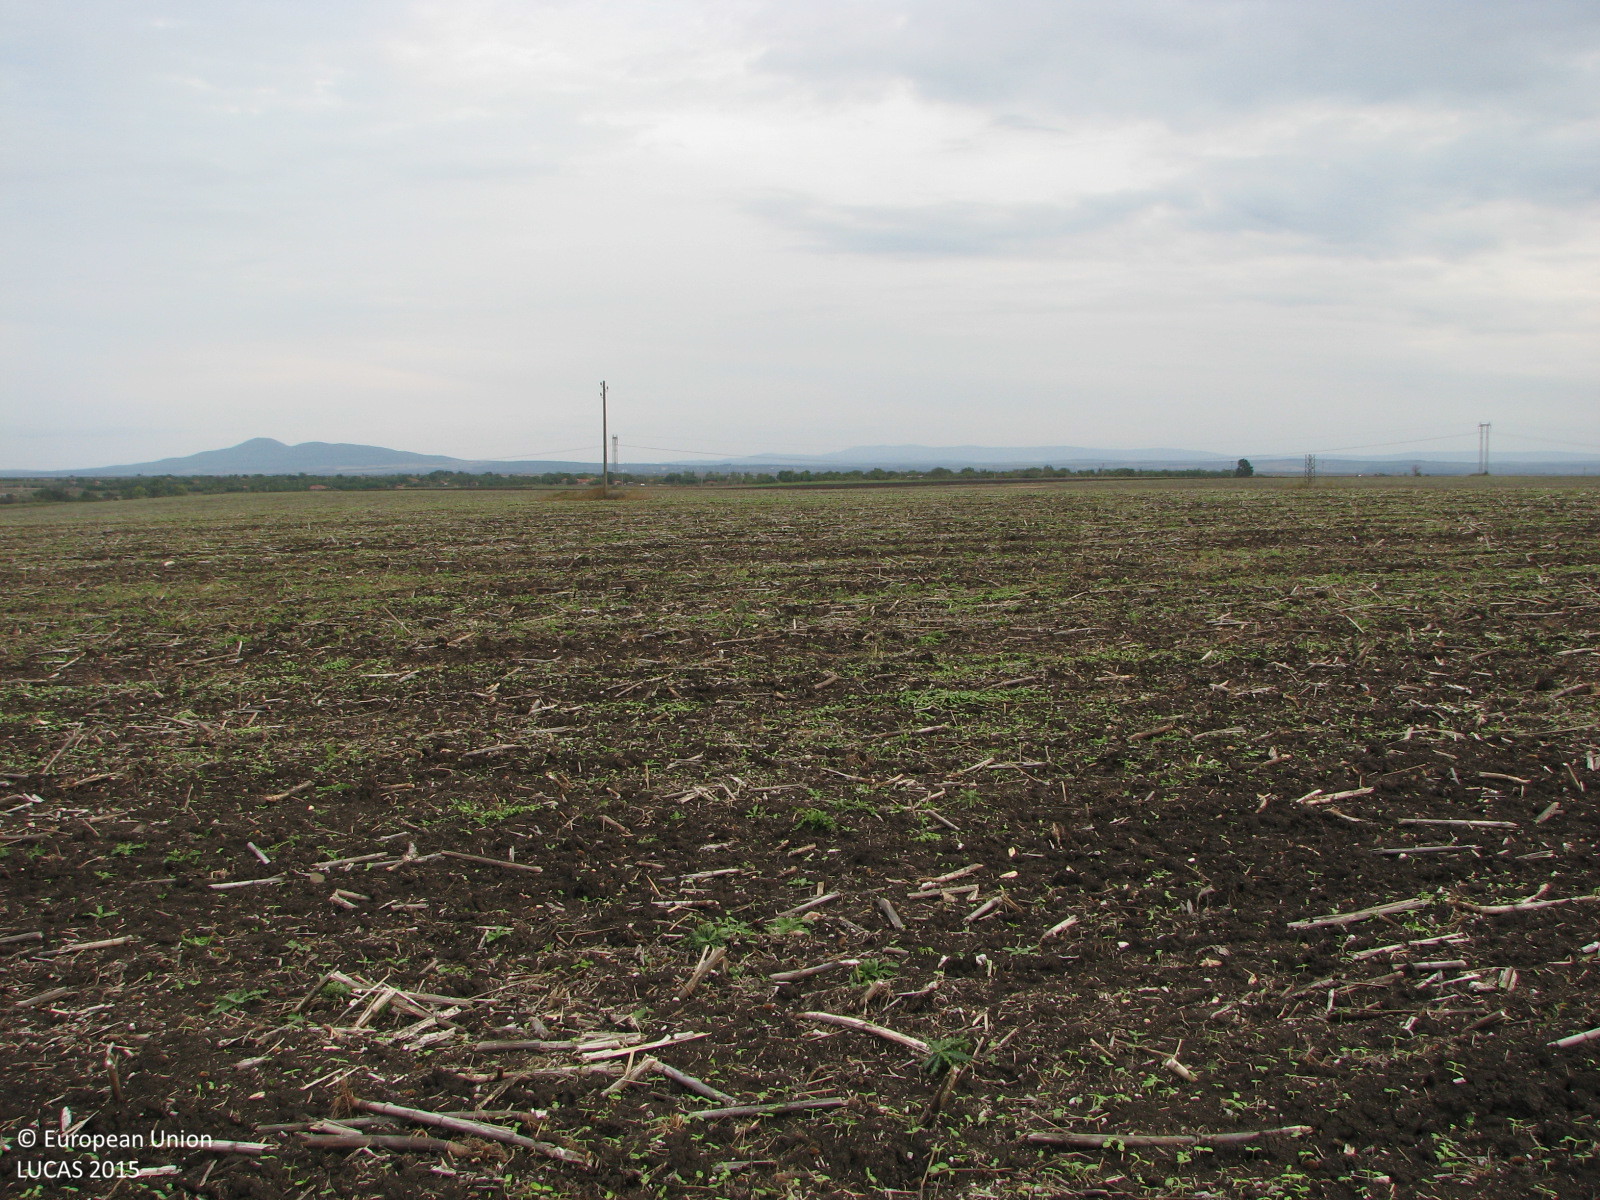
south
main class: Cropland
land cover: Sunflower
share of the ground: 10 - 25 %
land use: Agriculture (excluding fallow land and kitchen gardens)
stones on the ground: < 10 %
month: October
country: BG
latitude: 42.3695
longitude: 26.1978
